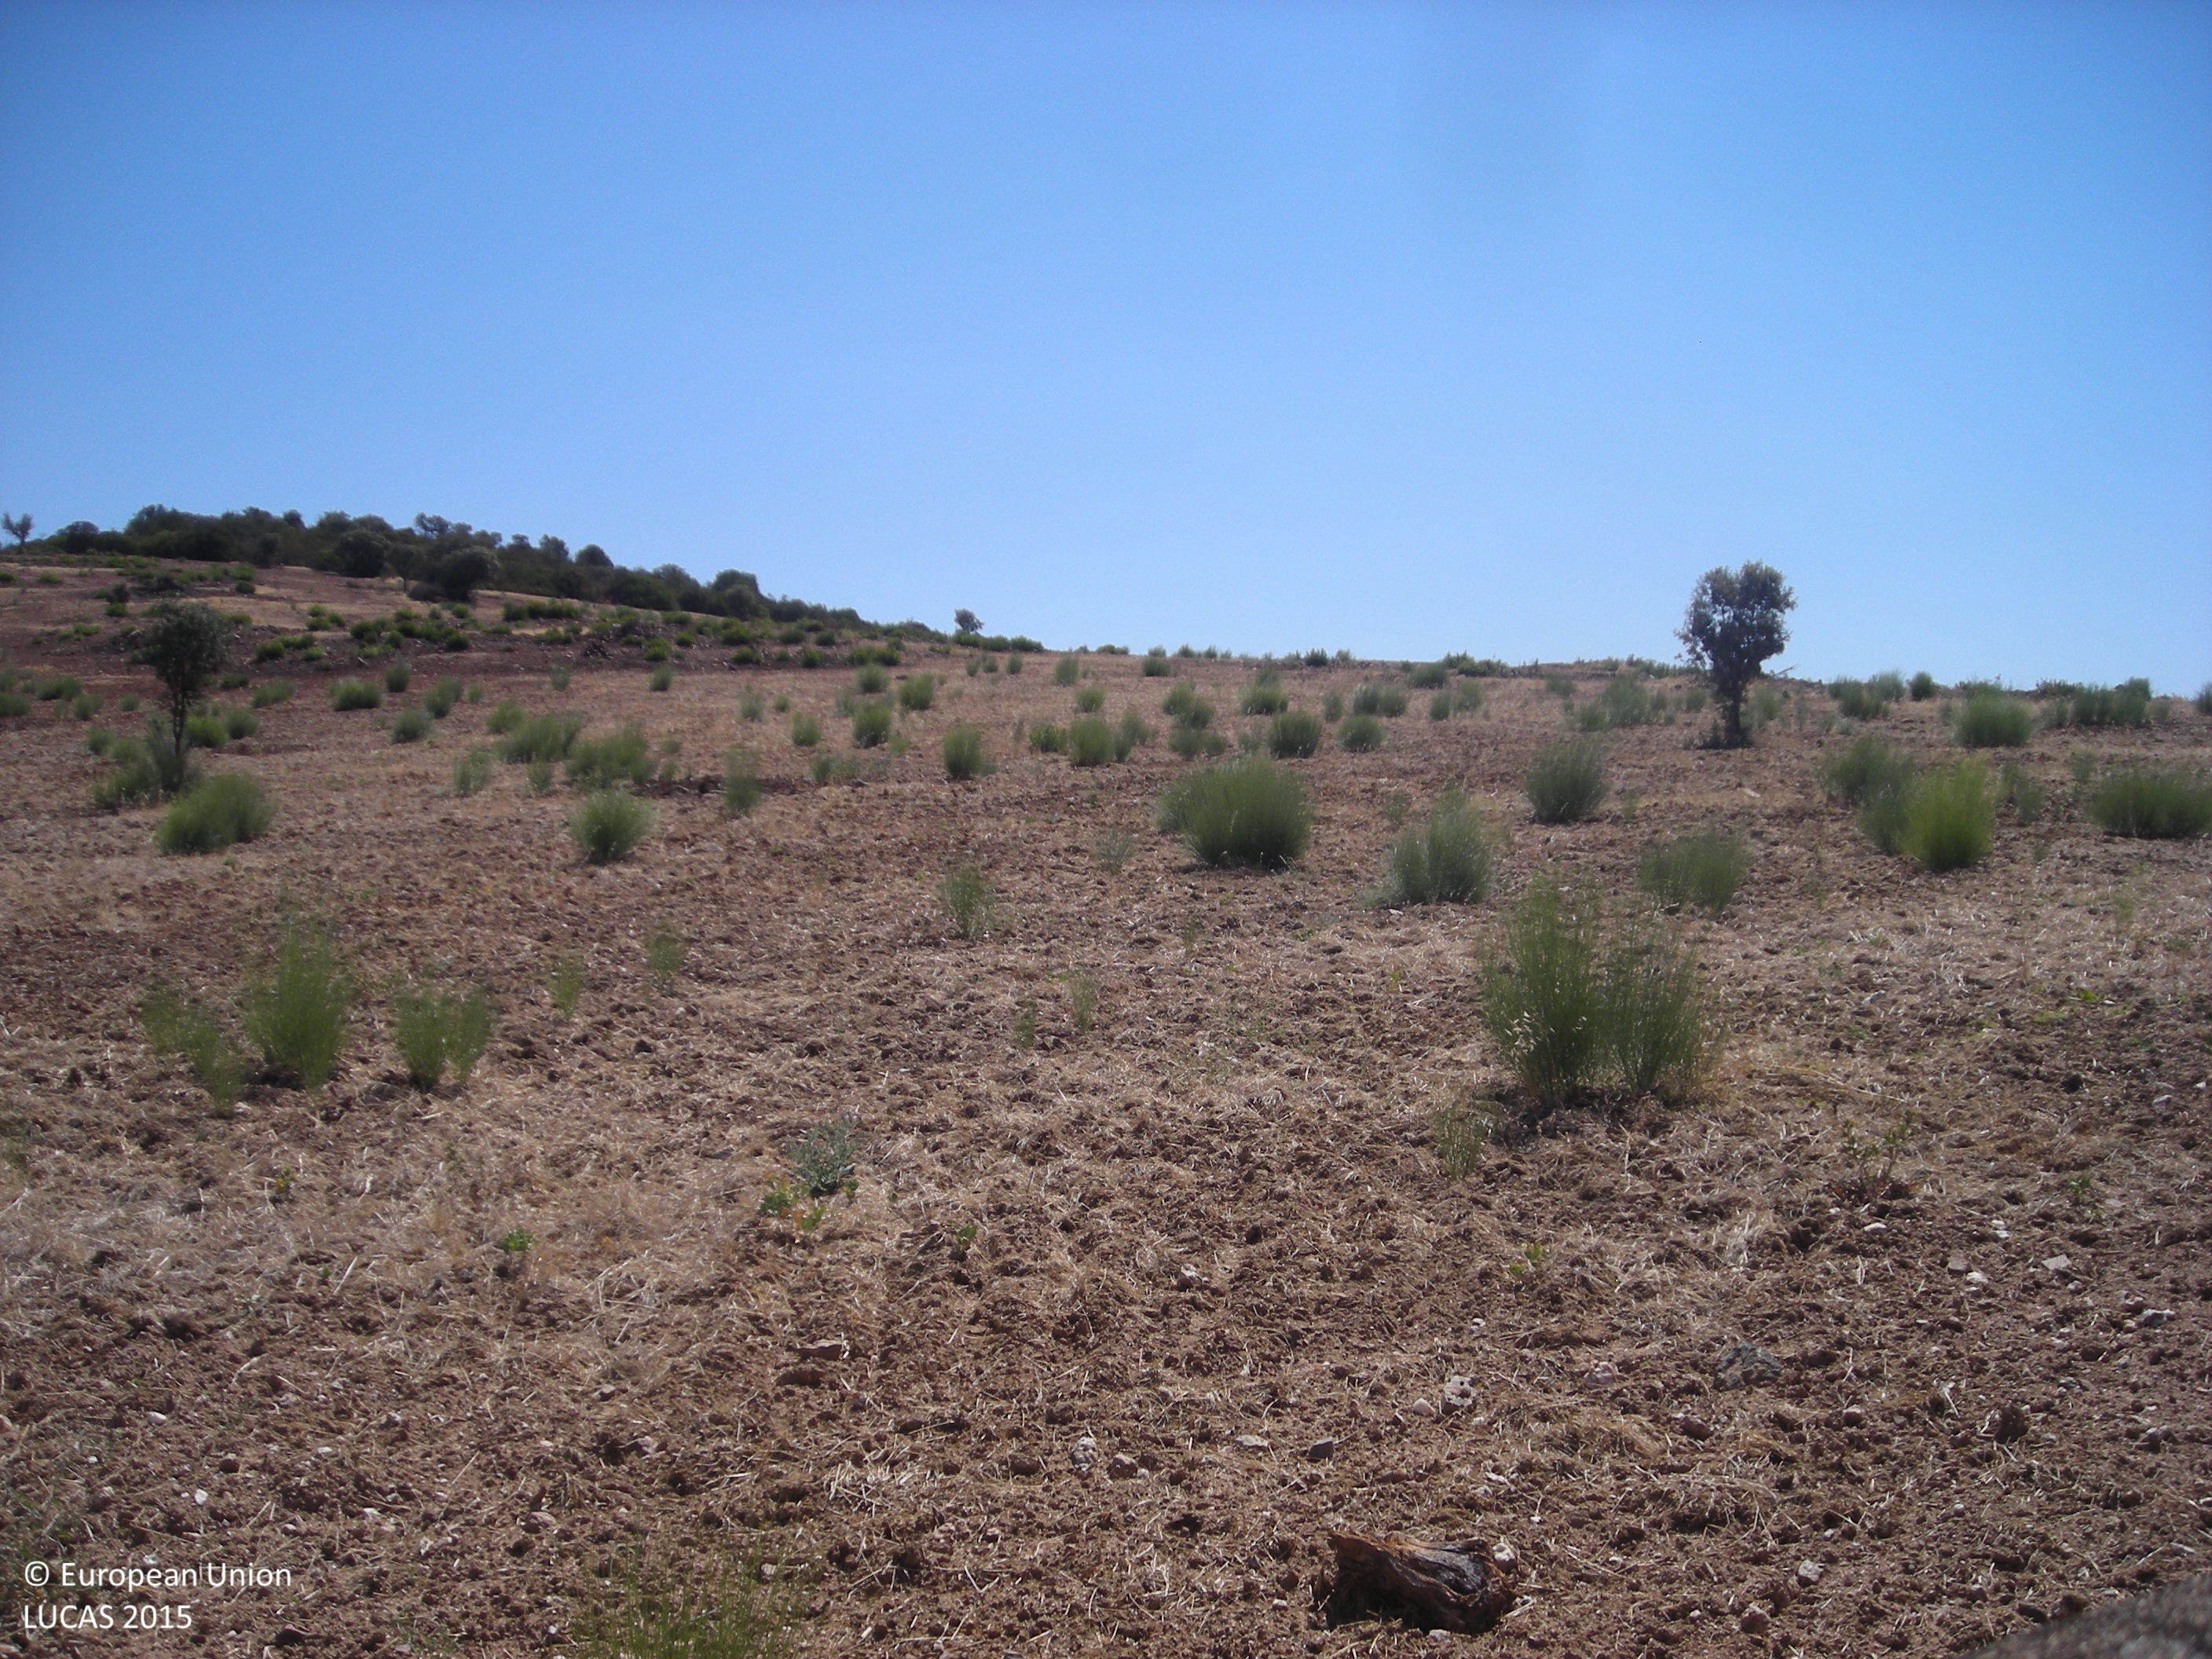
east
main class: Grassland
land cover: Grassland with sparse tree/shrub cover
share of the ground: > 75 %
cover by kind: herbaceous plants 85 %, shrubs 10 %, broadleaved forest trees 5 %
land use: Agriculture (excluding fallow land and kitchen gardens)
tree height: > 5 m
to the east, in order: Grassland with sparse tree/shrub cover; Dry stone walls; Arable land (only in case pi)
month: July
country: ES
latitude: 38.7954
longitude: -5.9016
